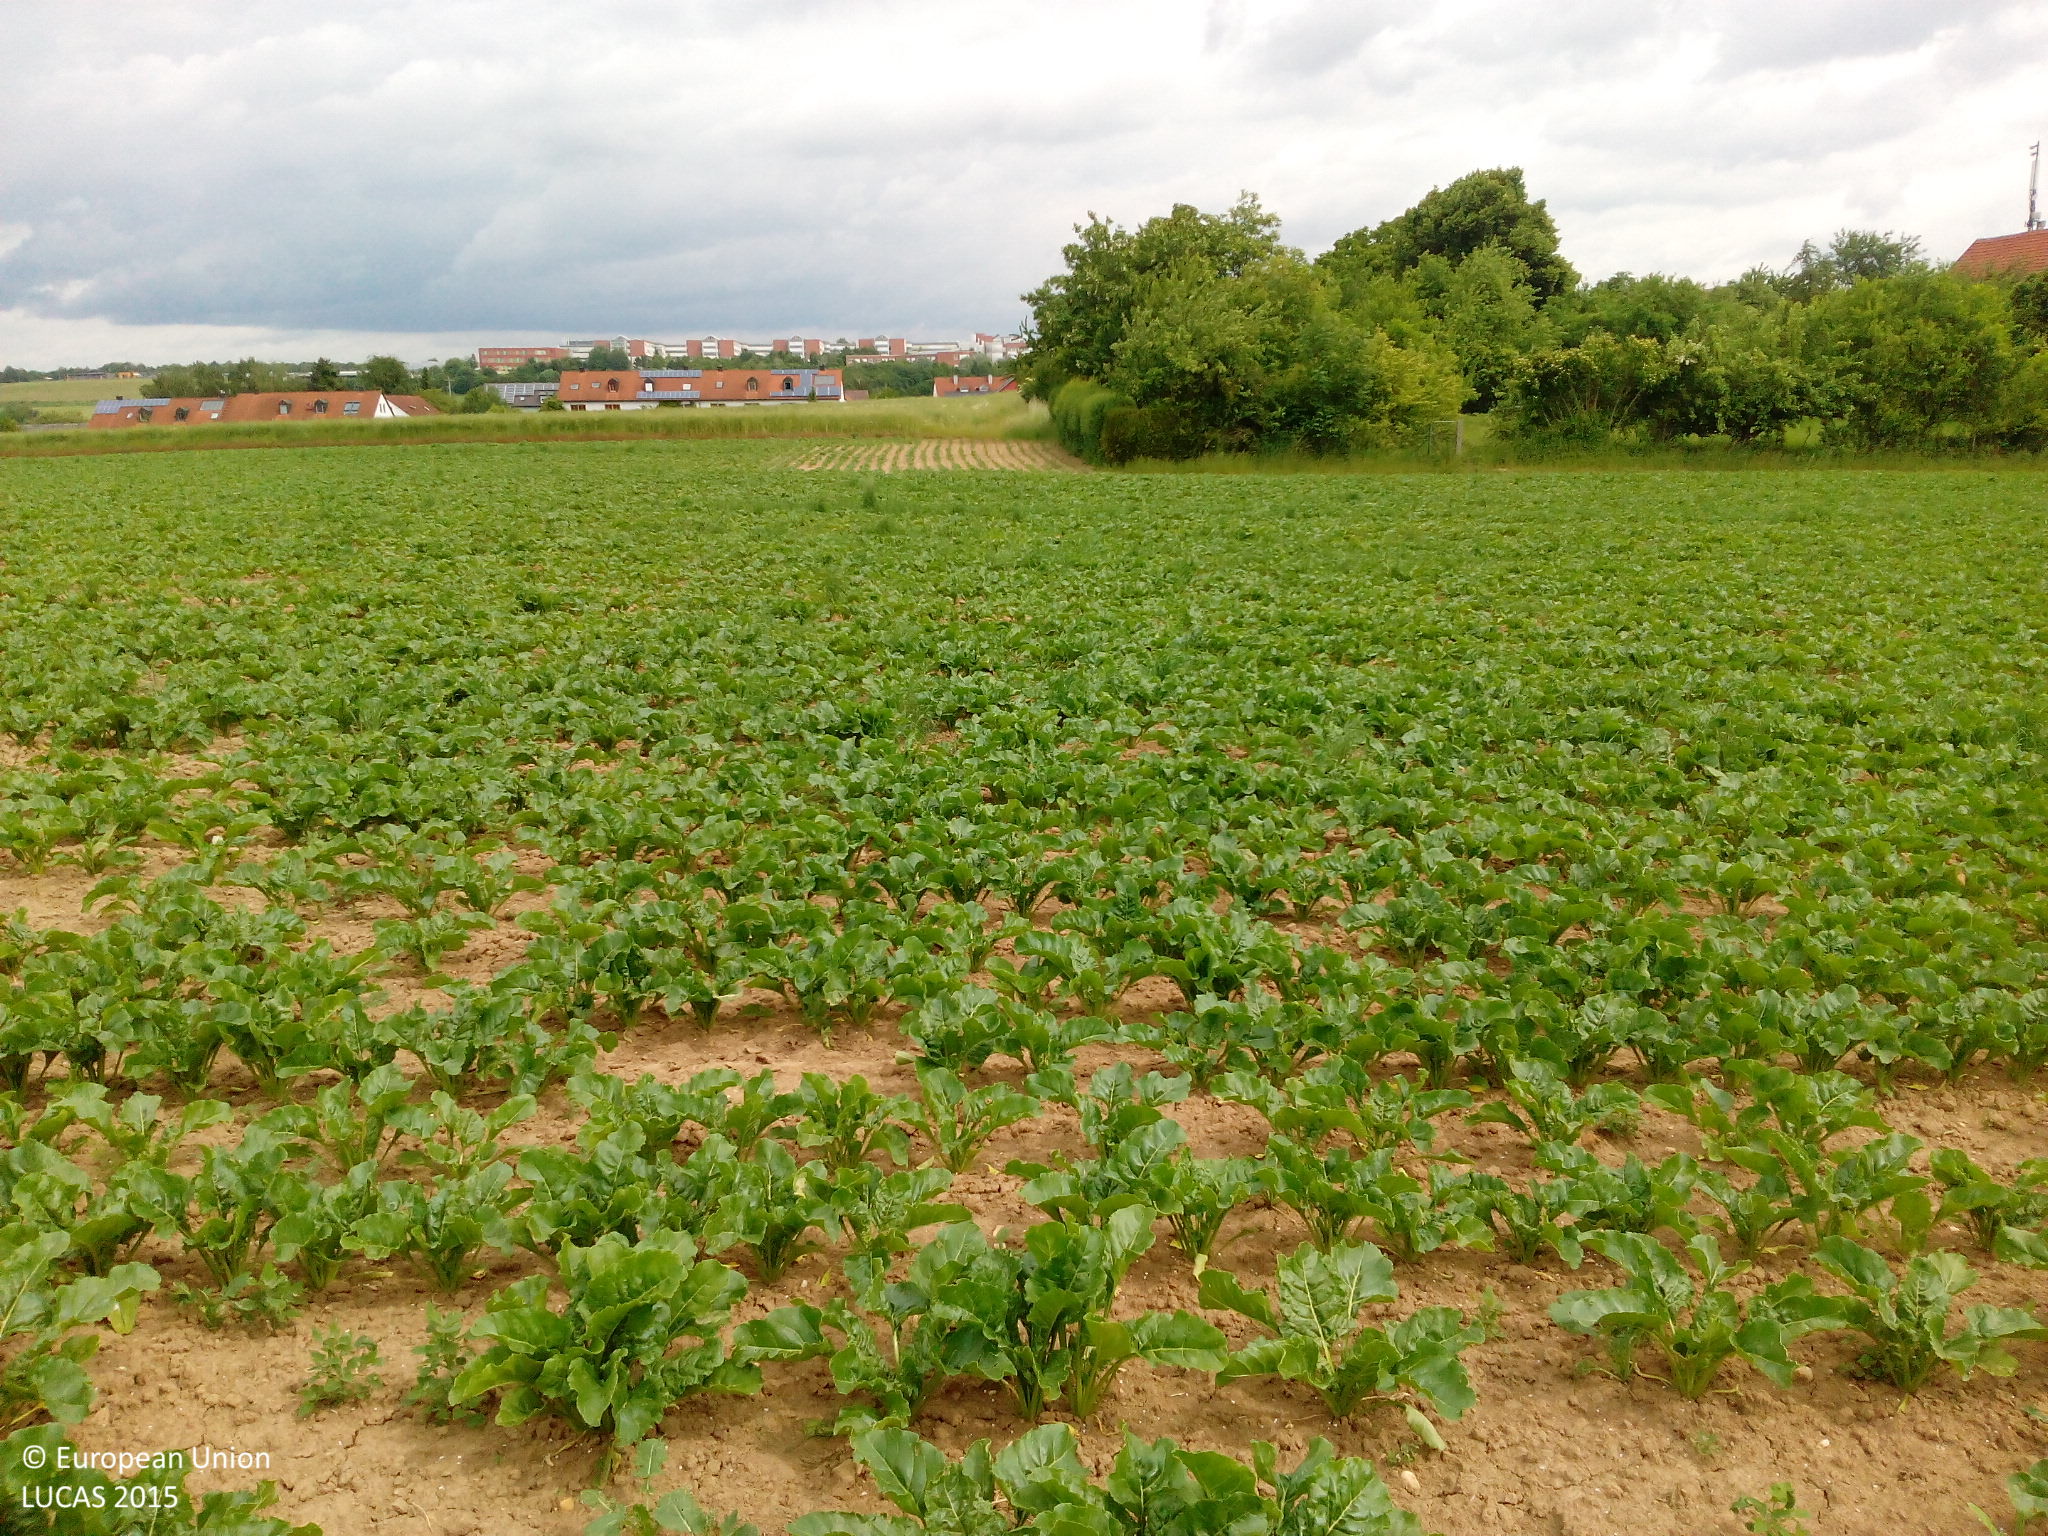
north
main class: Cropland
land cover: Rape and turnip rape
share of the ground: > 75 %
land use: Agriculture (excluding fallow land and kitchen gardens)
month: June
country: DE
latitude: 48.9777
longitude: 12.0898
